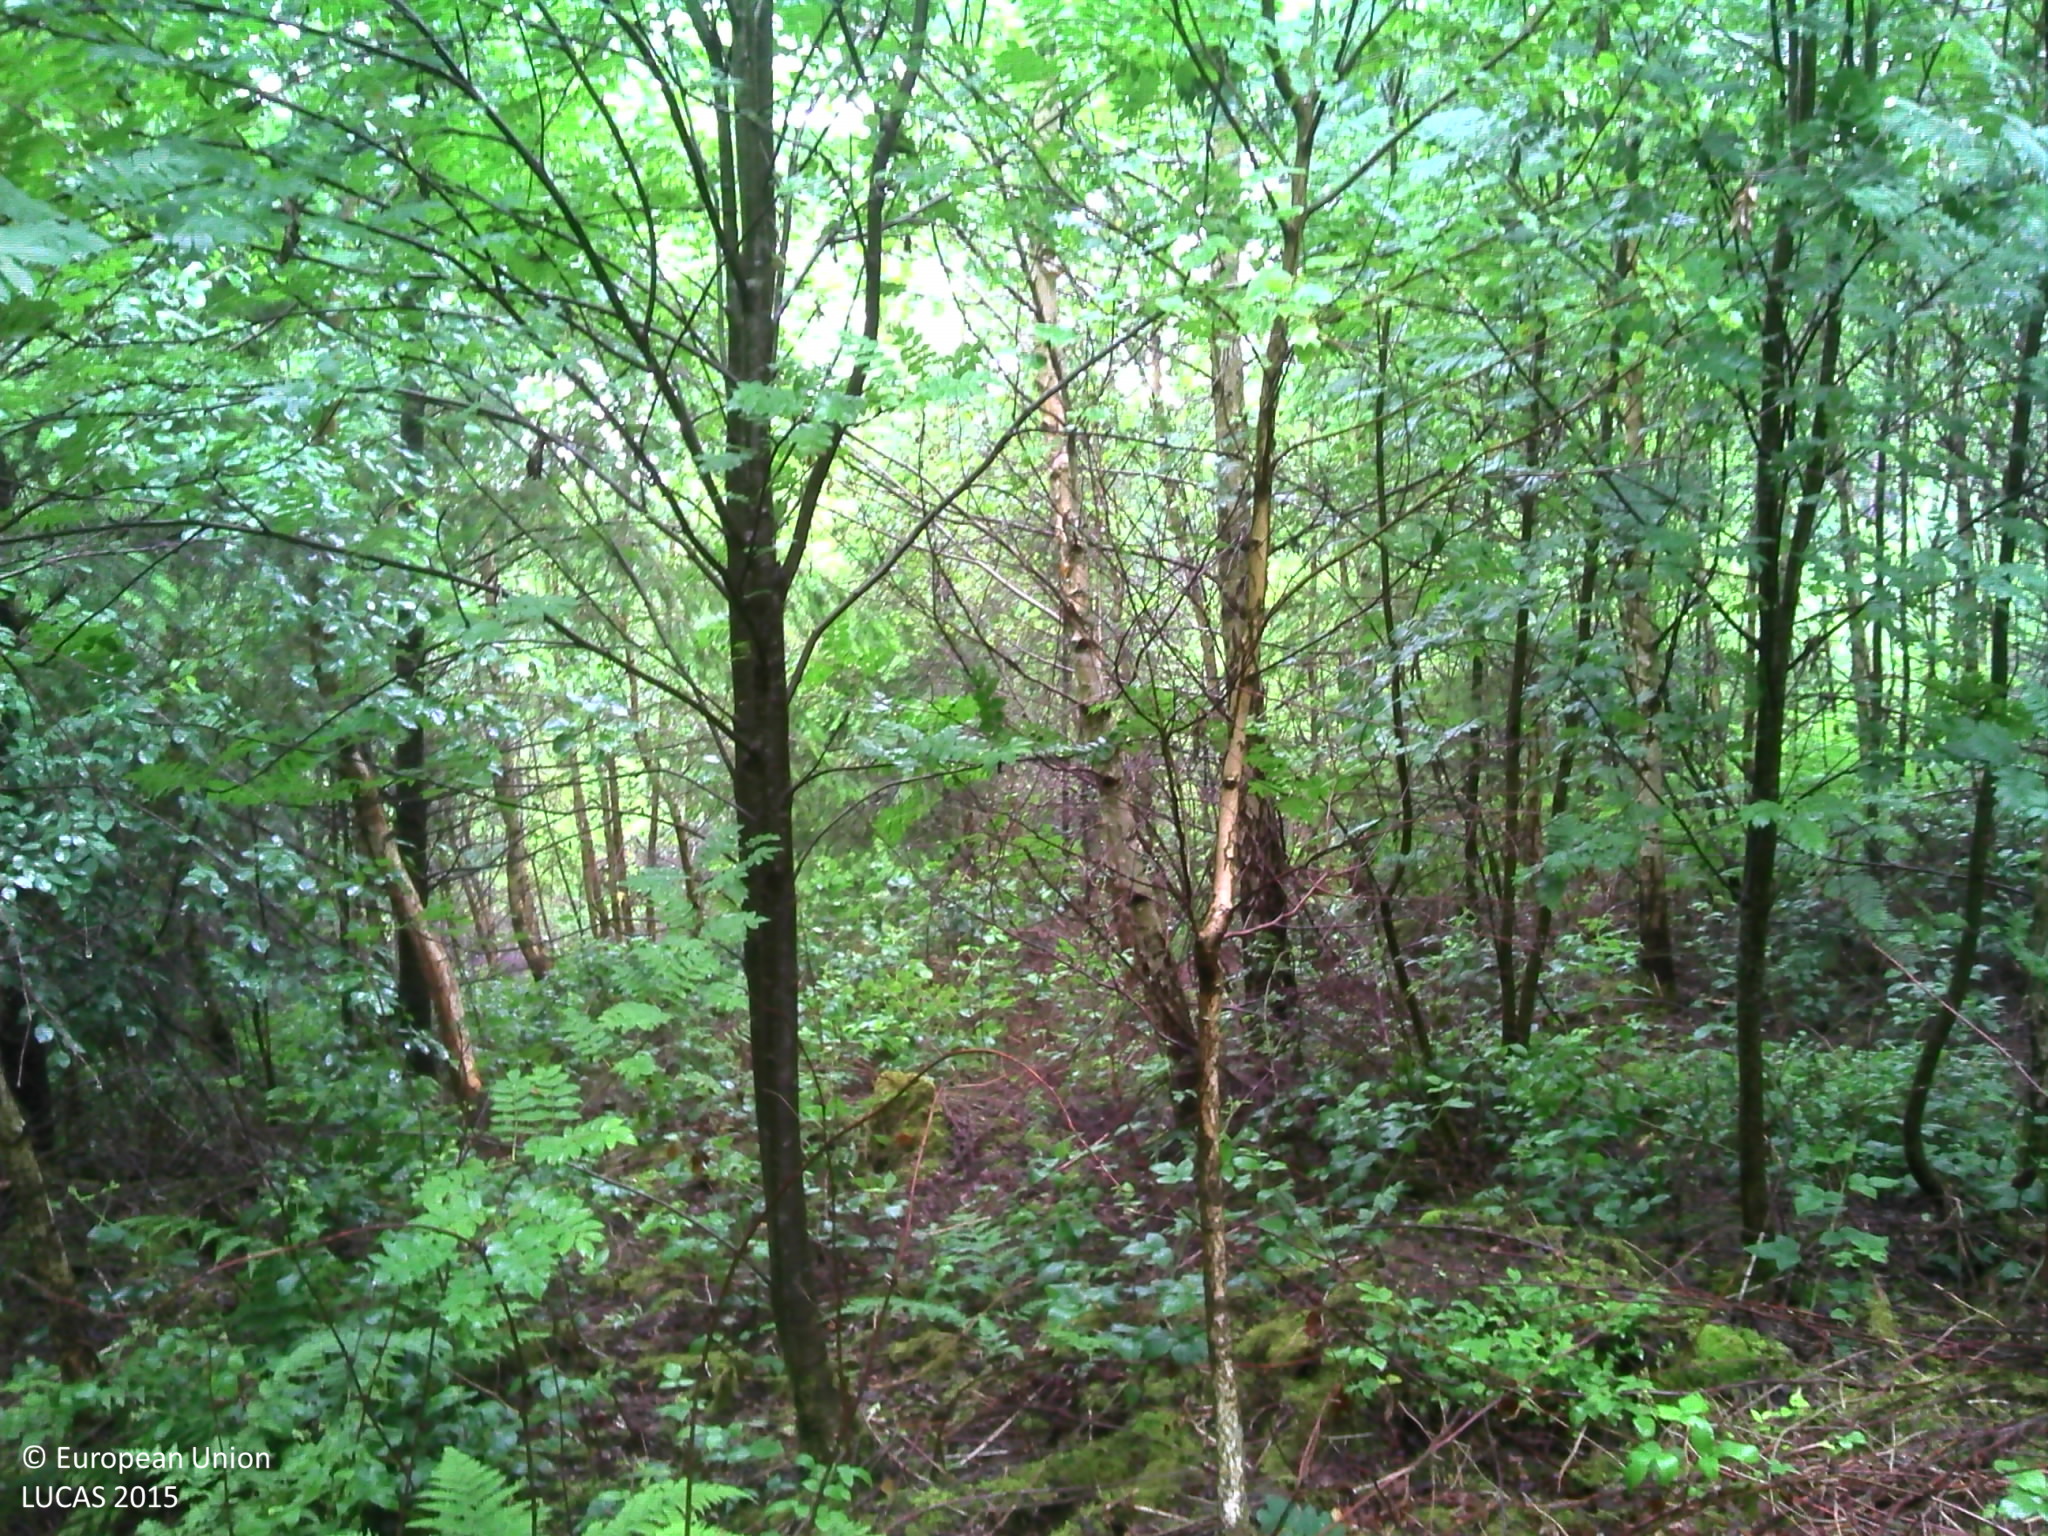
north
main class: Woodland
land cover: Broadleaved woodland
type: acidophilous oak and oak-birch forest
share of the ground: 50 - 75 %
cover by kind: broadleaved forest trees 70 %, shrubs 20 %, herbaceous plants 10 %
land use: Forestry
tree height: > 5 m
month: June
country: BE
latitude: 50.2035
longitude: 5.5009
